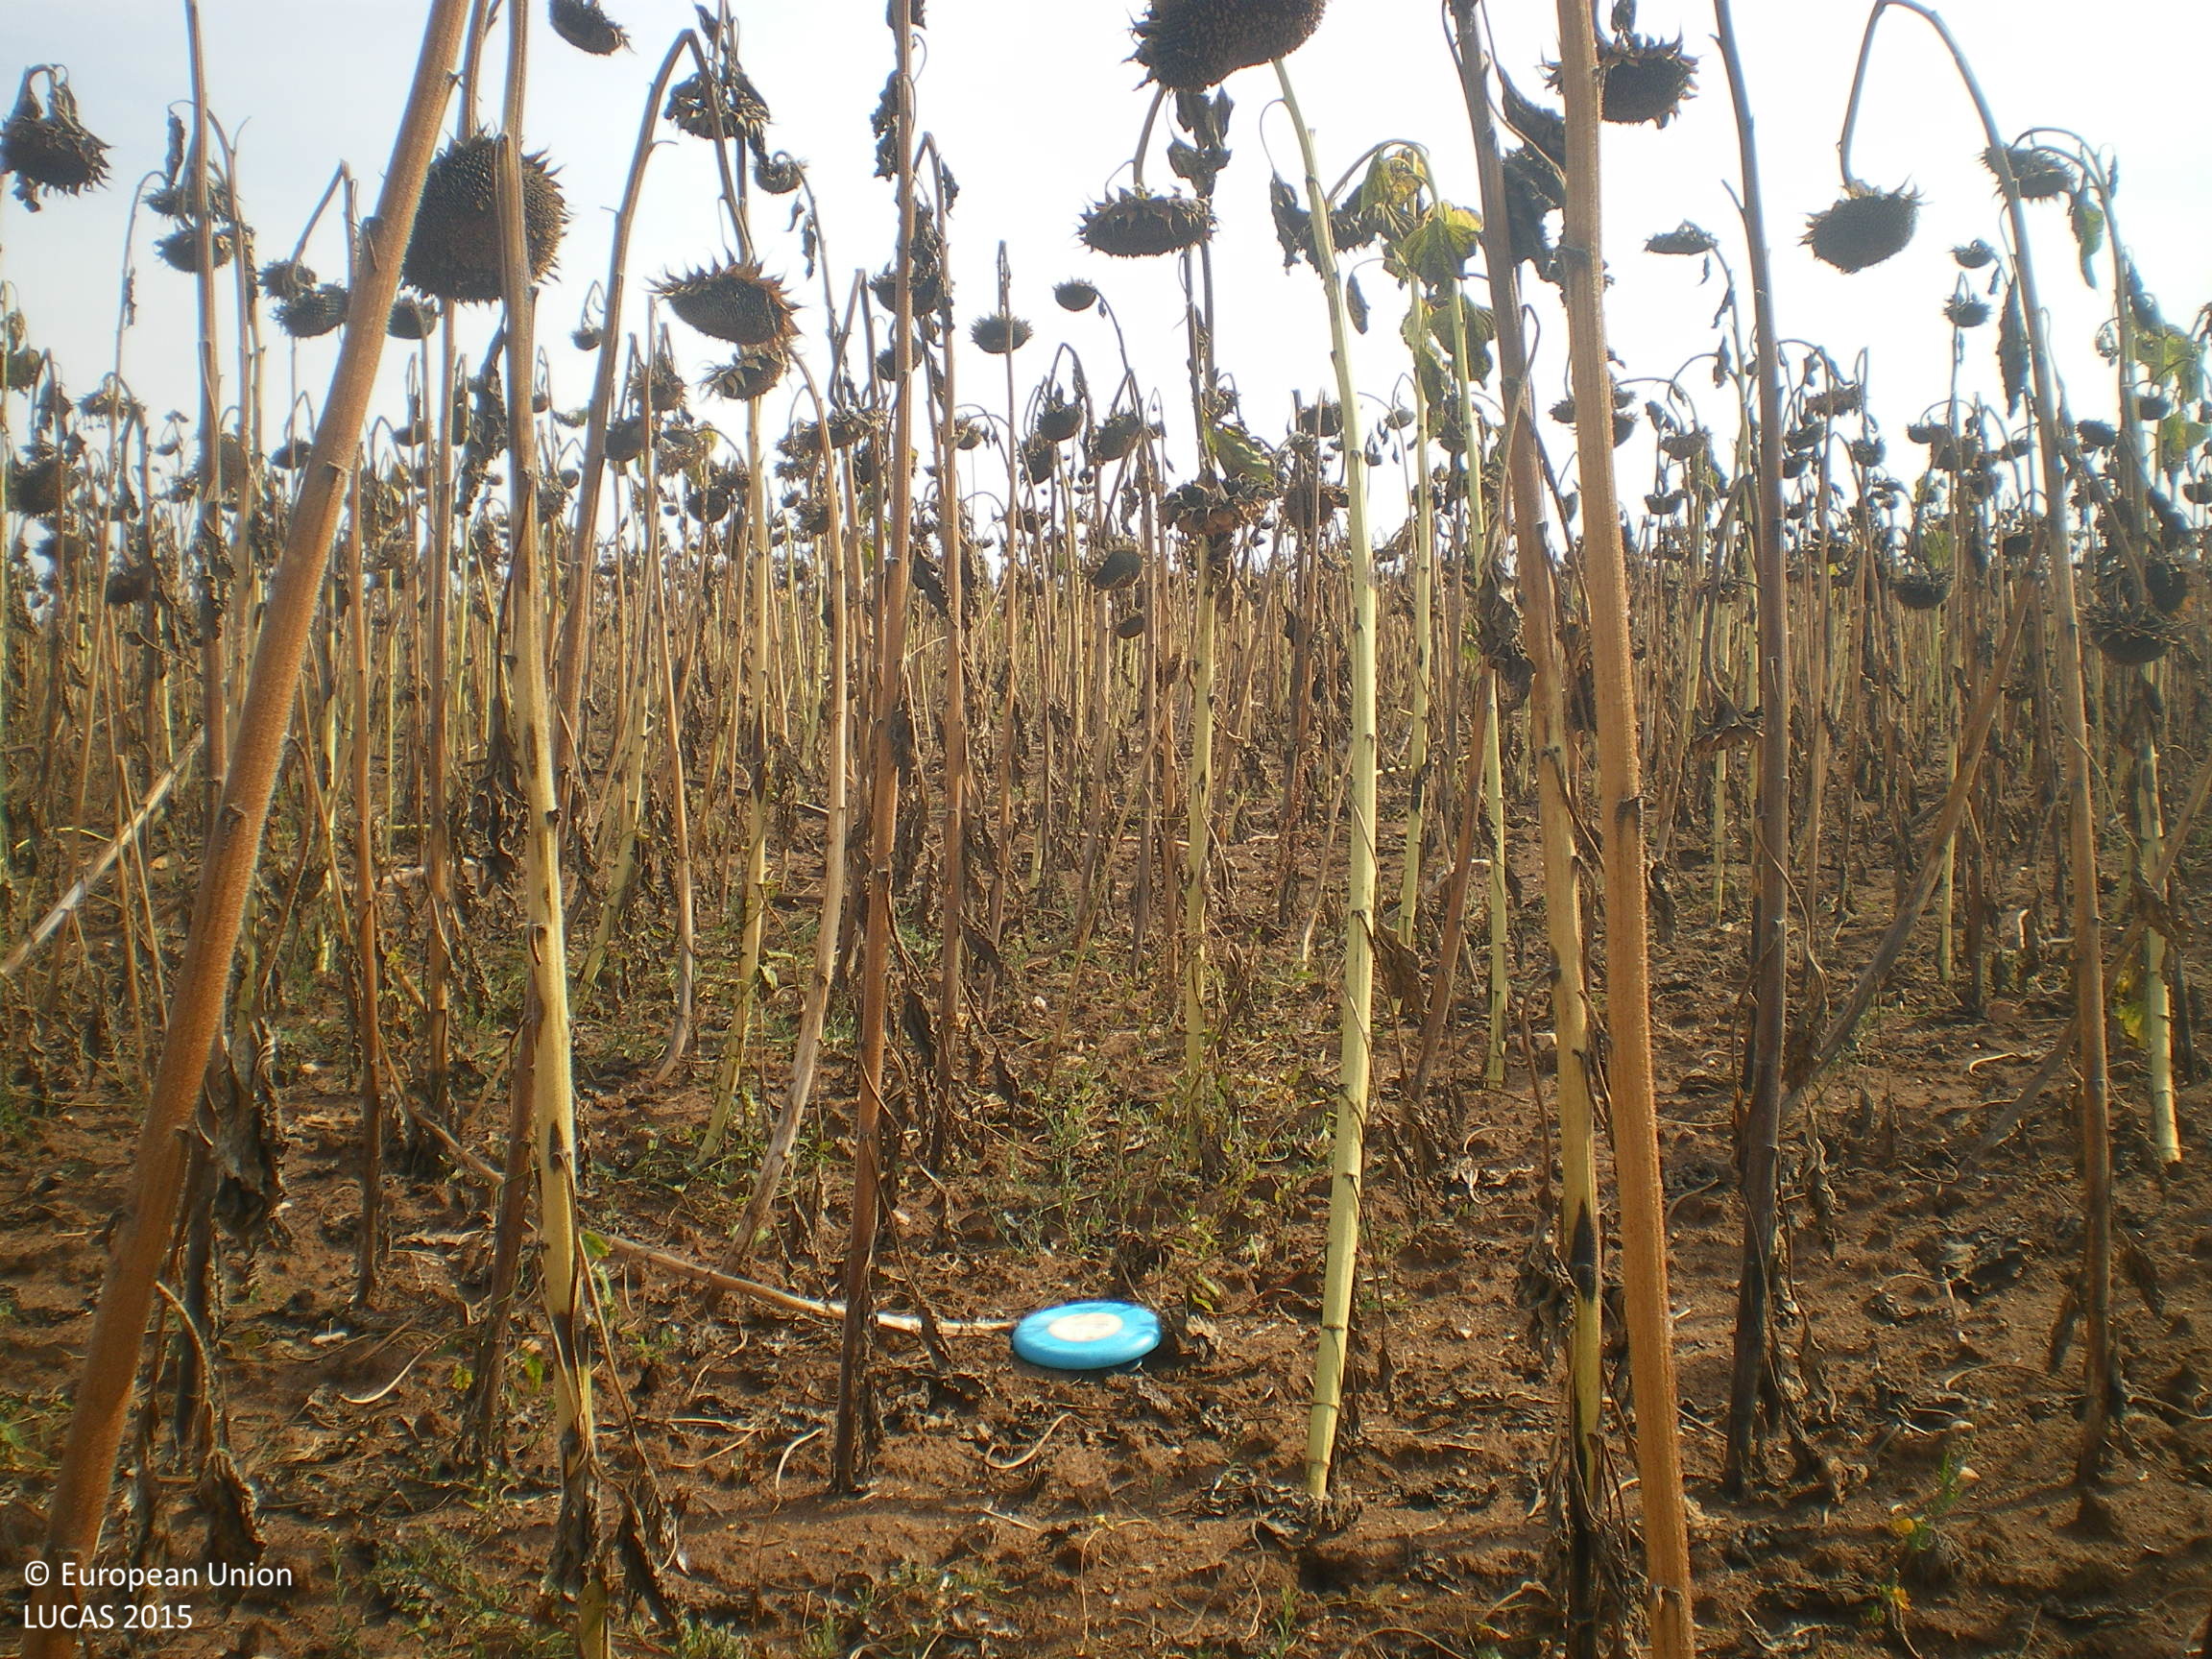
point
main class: Cropland
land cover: Sunflower
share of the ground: > 75 %
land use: Agriculture (excluding fallow land and kitchen gardens)
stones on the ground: < 10 %
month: September
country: BG
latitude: 42.1622
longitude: 26.1164
